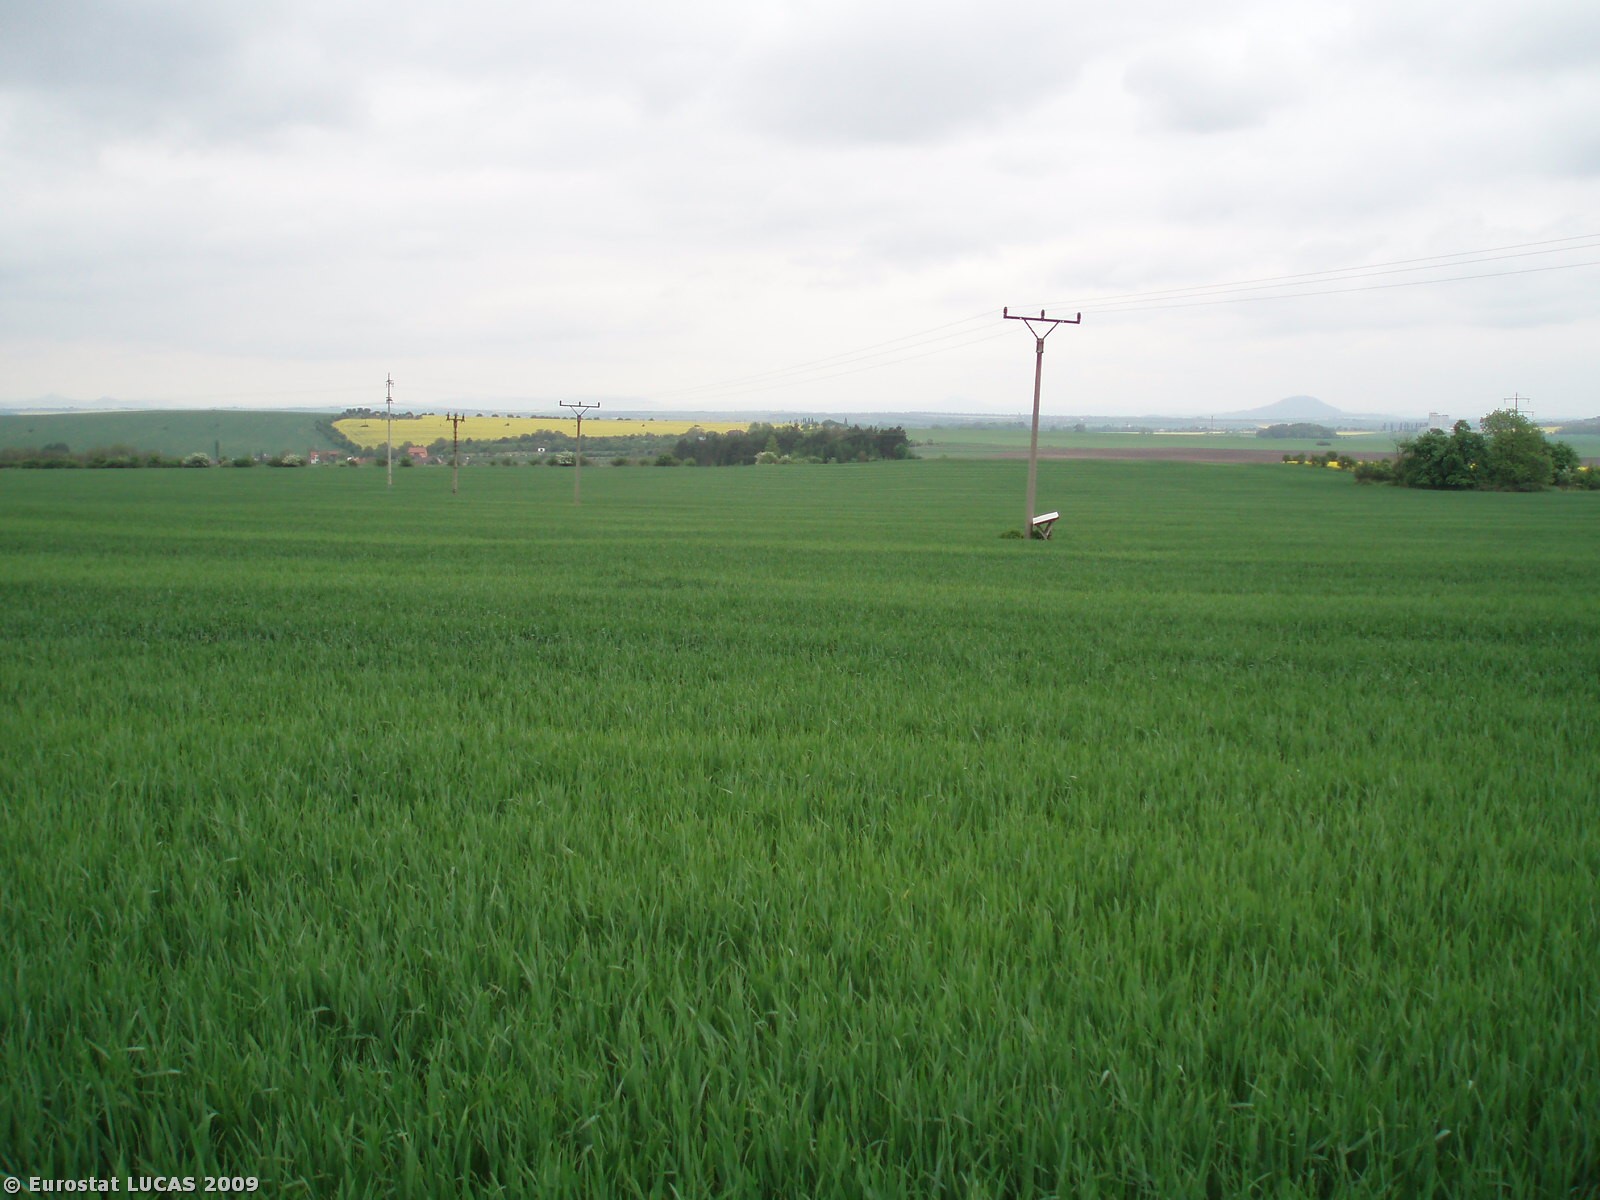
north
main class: Cropland
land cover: Common wheat
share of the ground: > 75 %
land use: Agriculture (excluding fallow land and kitchen gardens)
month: May
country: CZ
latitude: 50.2322
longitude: 14.2210
